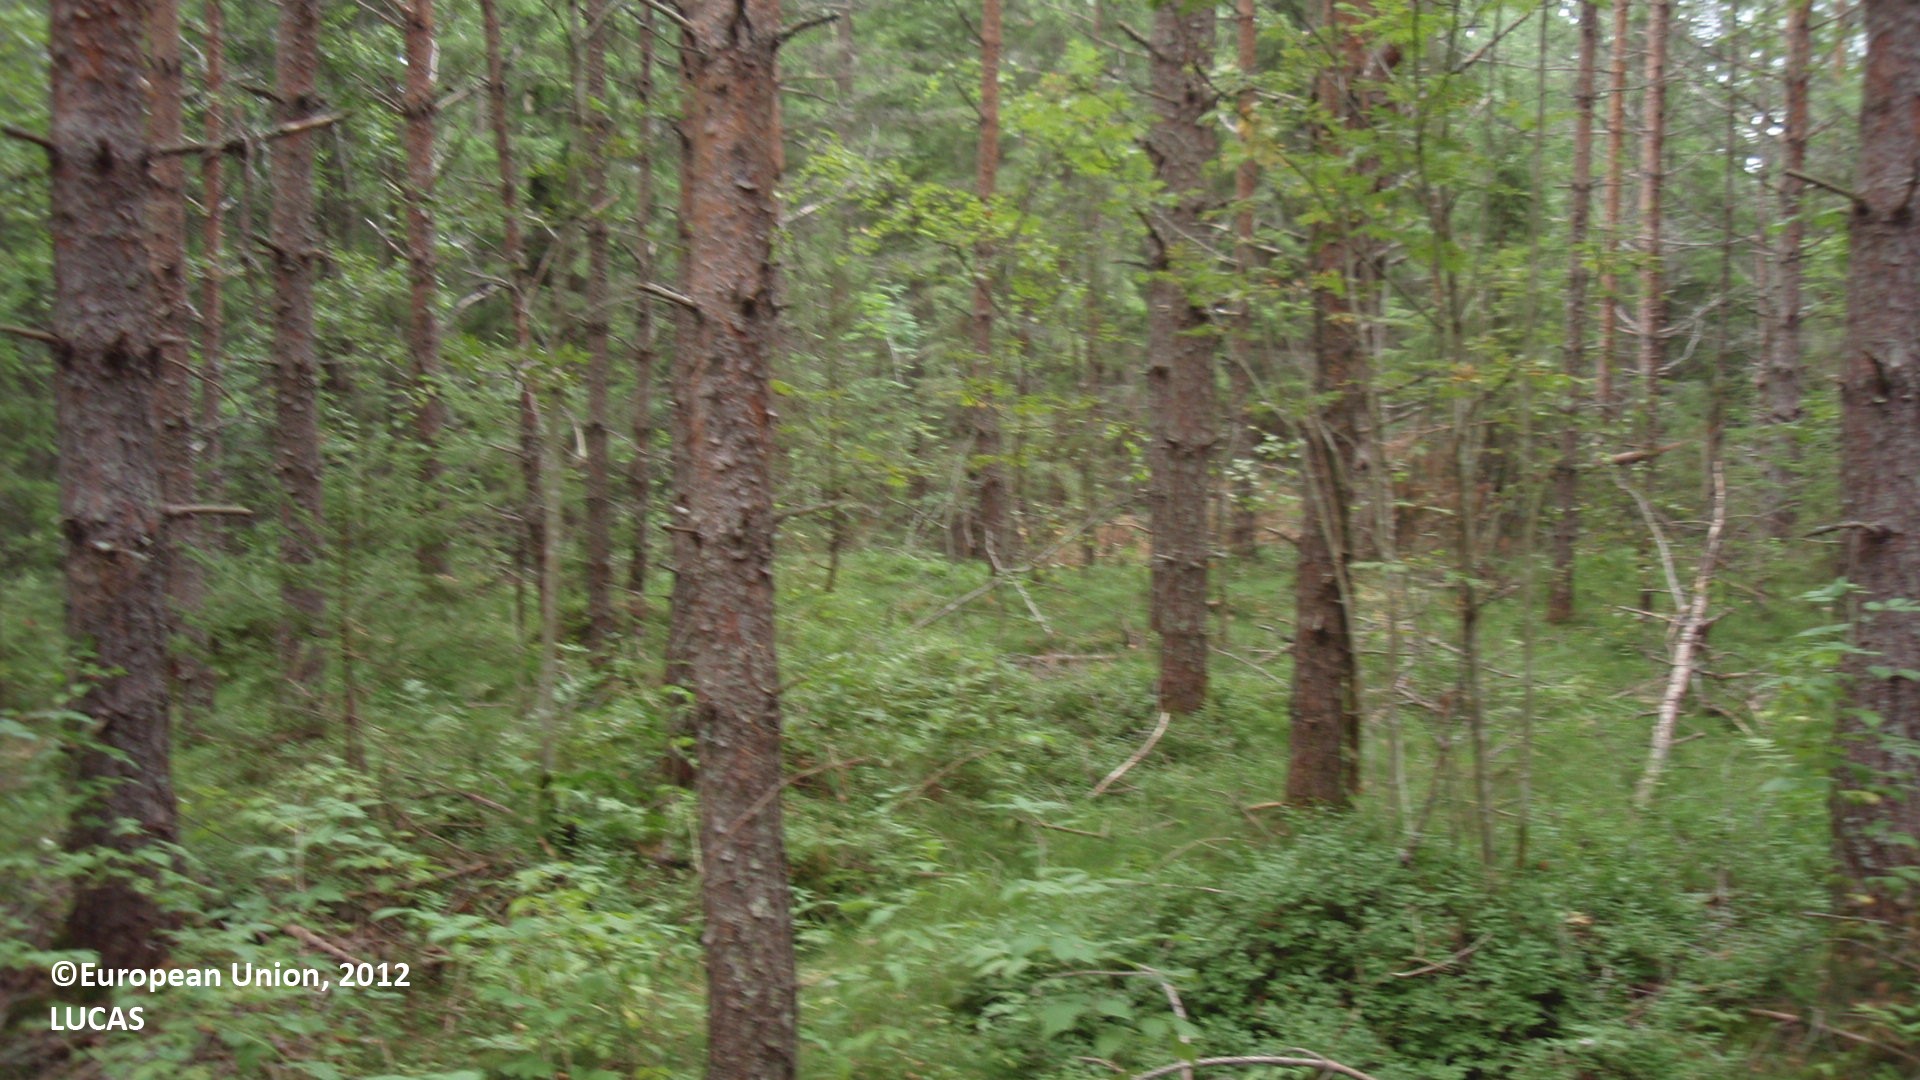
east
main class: Woodland
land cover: Pine dominated mixed woodland
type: boreal forest
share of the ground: > 75 %
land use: Forestry
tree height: > 5 m
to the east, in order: Pine dominated mixed woodland; Broadleaved woodland; Spruce dominated coniferous woodland; Grass margins; Oats; Ditches and canals; Oats; Ditches and canals; Oats
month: August
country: FI
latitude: 61.0890
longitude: 27.6729
